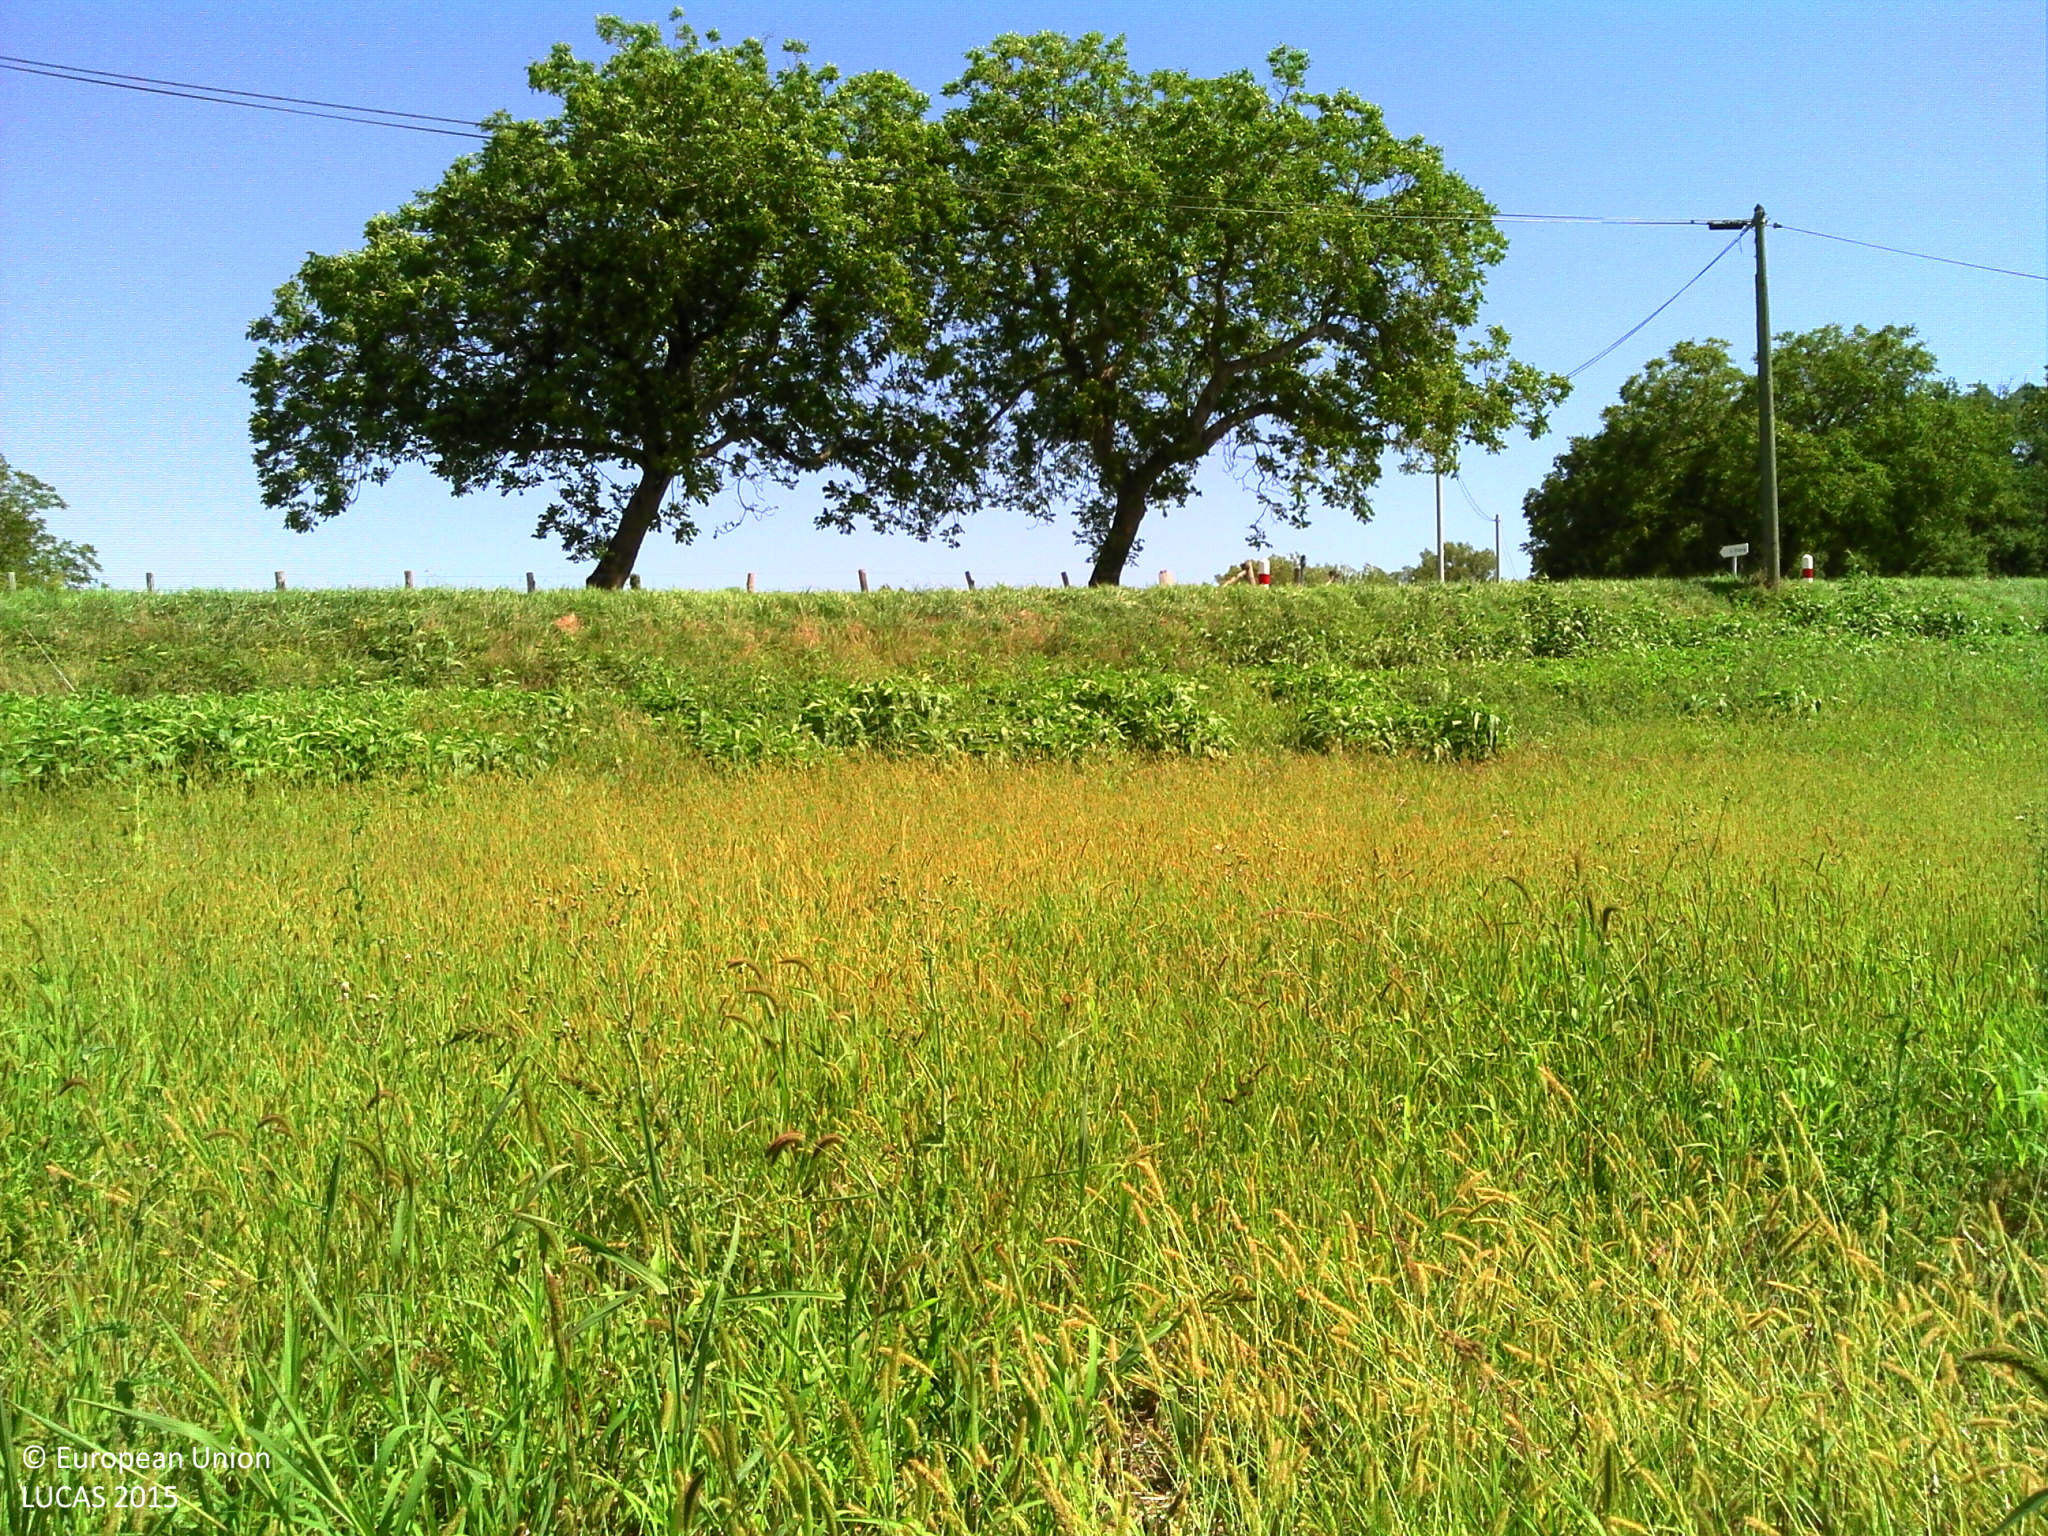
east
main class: Grassland
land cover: Grassland without tree/shrub cover
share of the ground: > 75 %
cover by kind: herbaceous plants 100 %
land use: Agriculture (excluding fallow land and kitchen gardens)
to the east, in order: Grassland without tree/shrub cover; Electric lines; Paved roads, cycling and walking lanes; Grass margins; Ditches and canals; Fences; Single bushes/trees; Grassland without tree/shrub cover; Abandoned hedges; Fences; Grassland without tree/shrub cover; Fences; Grassland with sparse tree/shrub cover
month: August
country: FR
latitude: 45.2382
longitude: 0.4979
